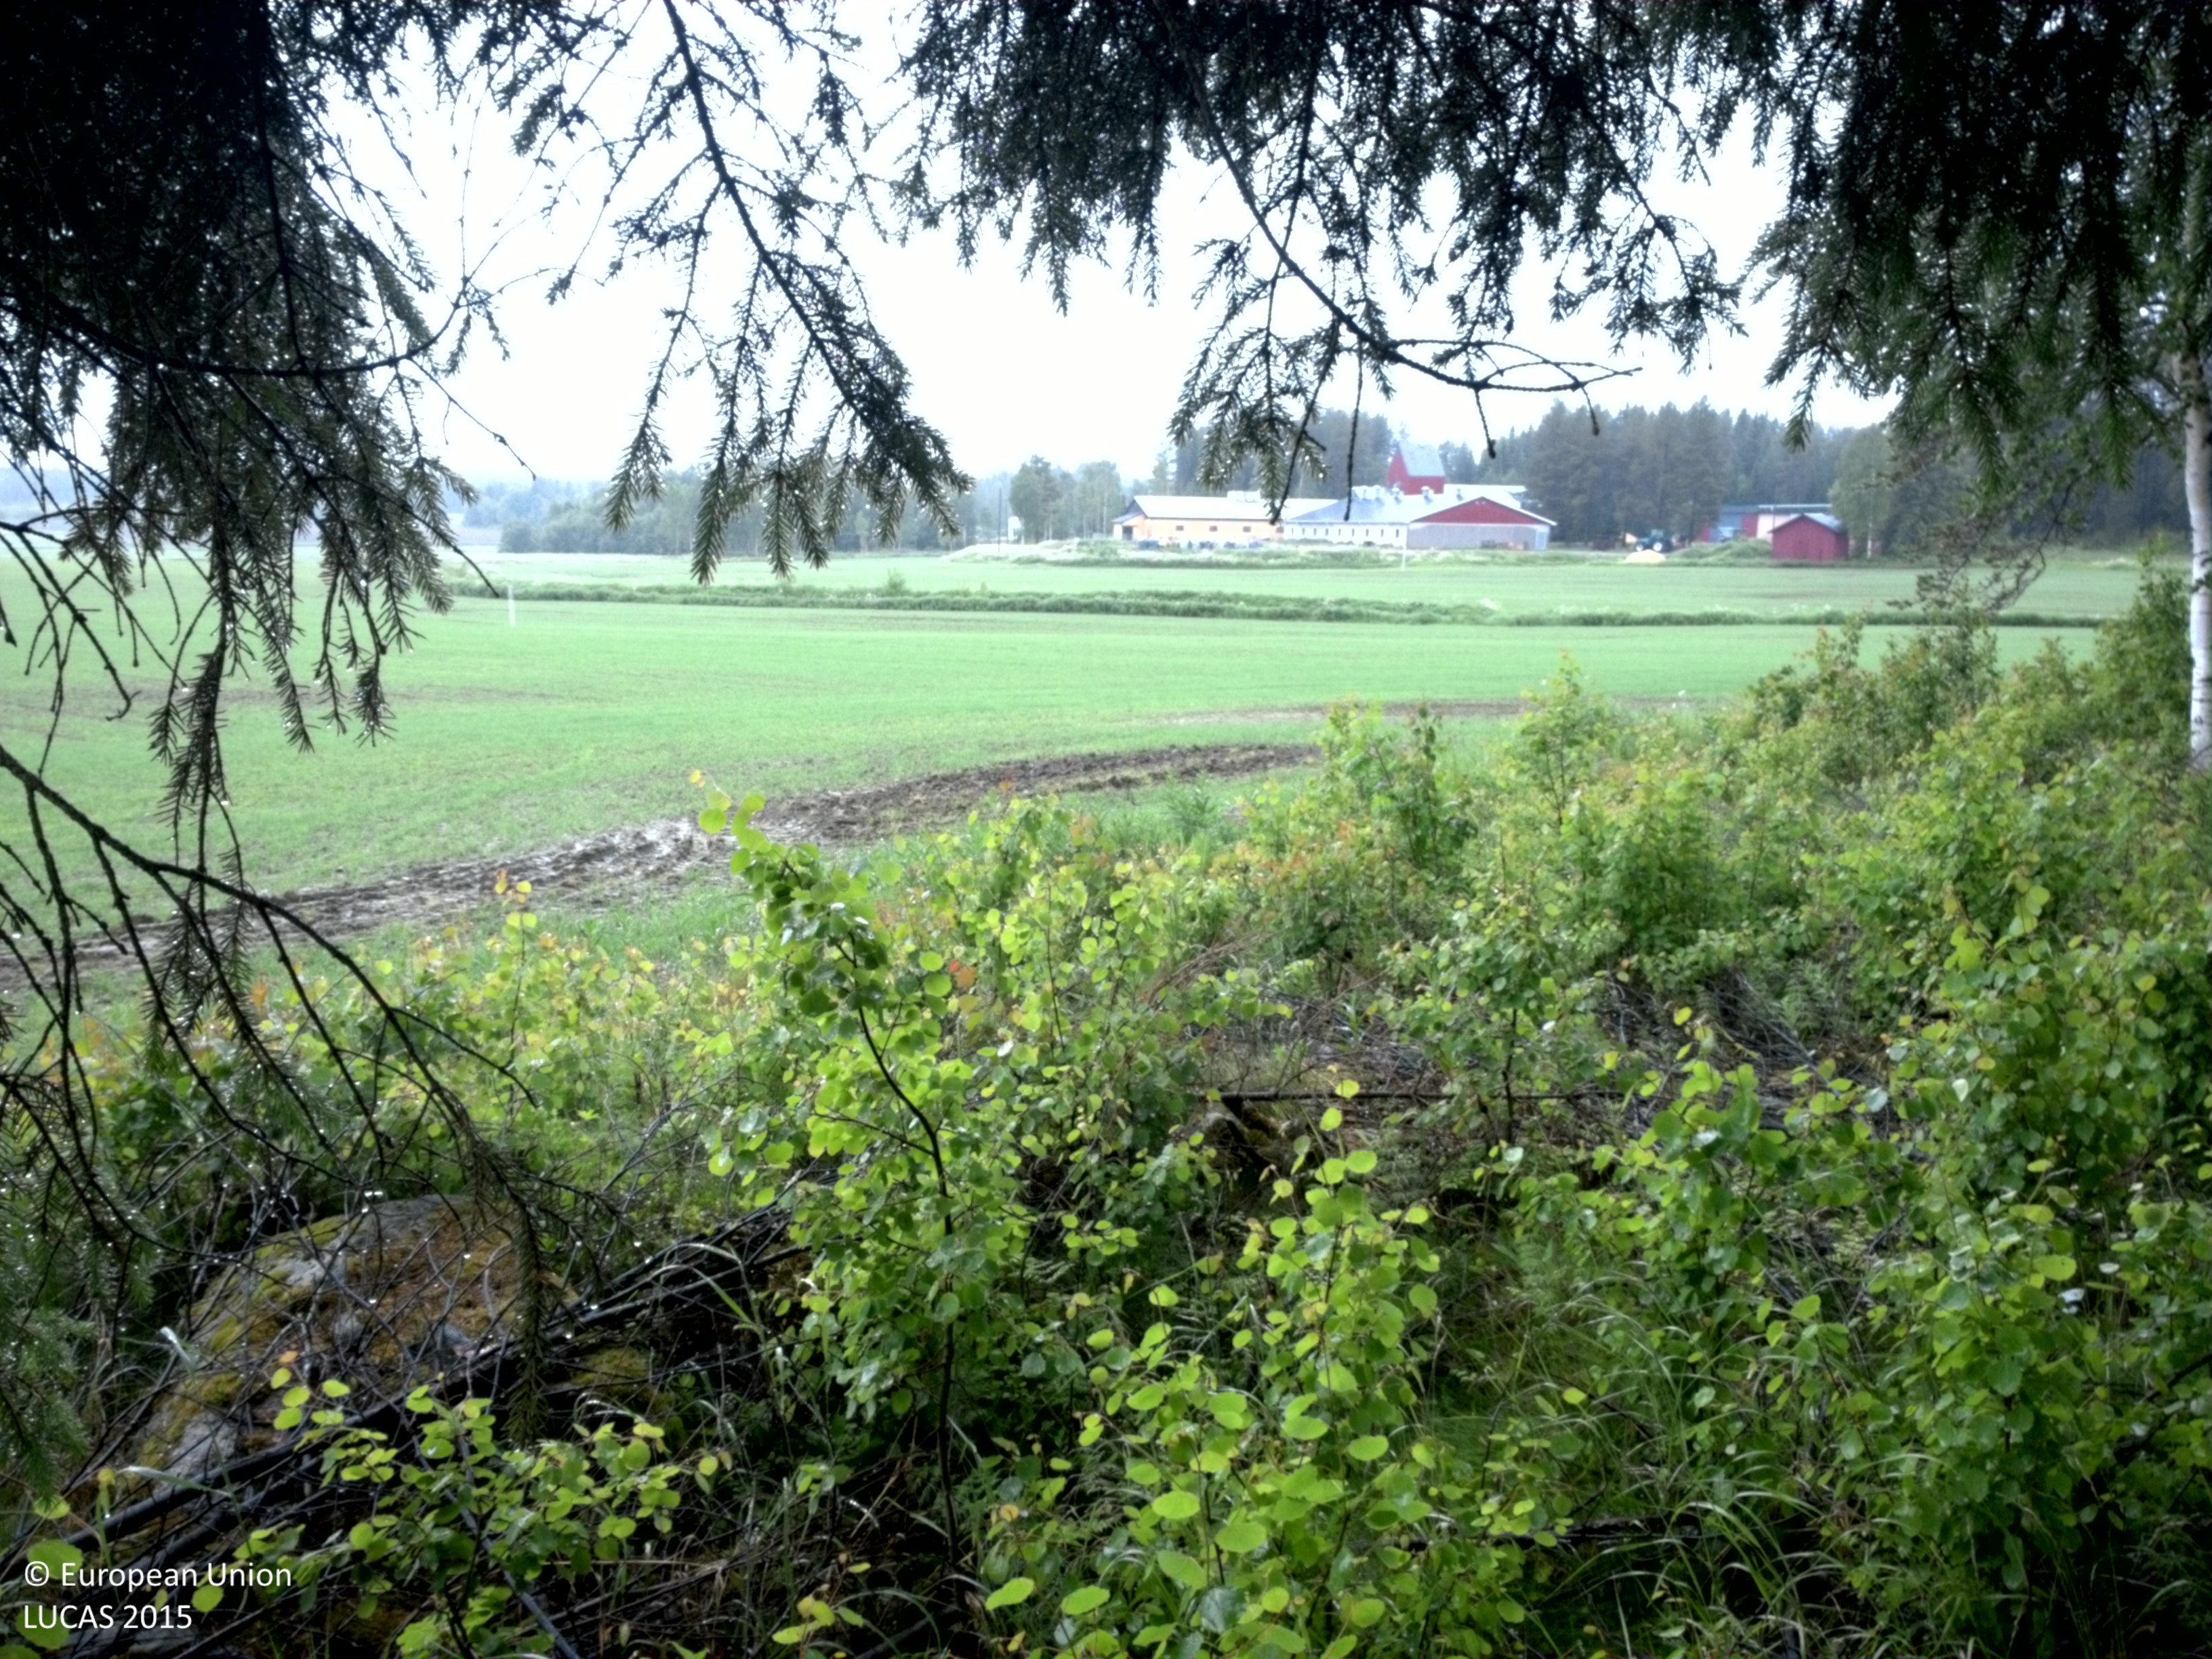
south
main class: Woodland
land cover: Spruce dominated coniferous woodland
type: boreal forest
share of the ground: 50 - 75 %
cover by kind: coniferous forest trees 65 %, shrubs 25 %, broadleaved forest trees 5 %, herbaceous plants 5 %
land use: Forestry
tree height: > 5 m
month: June
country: SE
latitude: 64.3361
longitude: 20.8460
